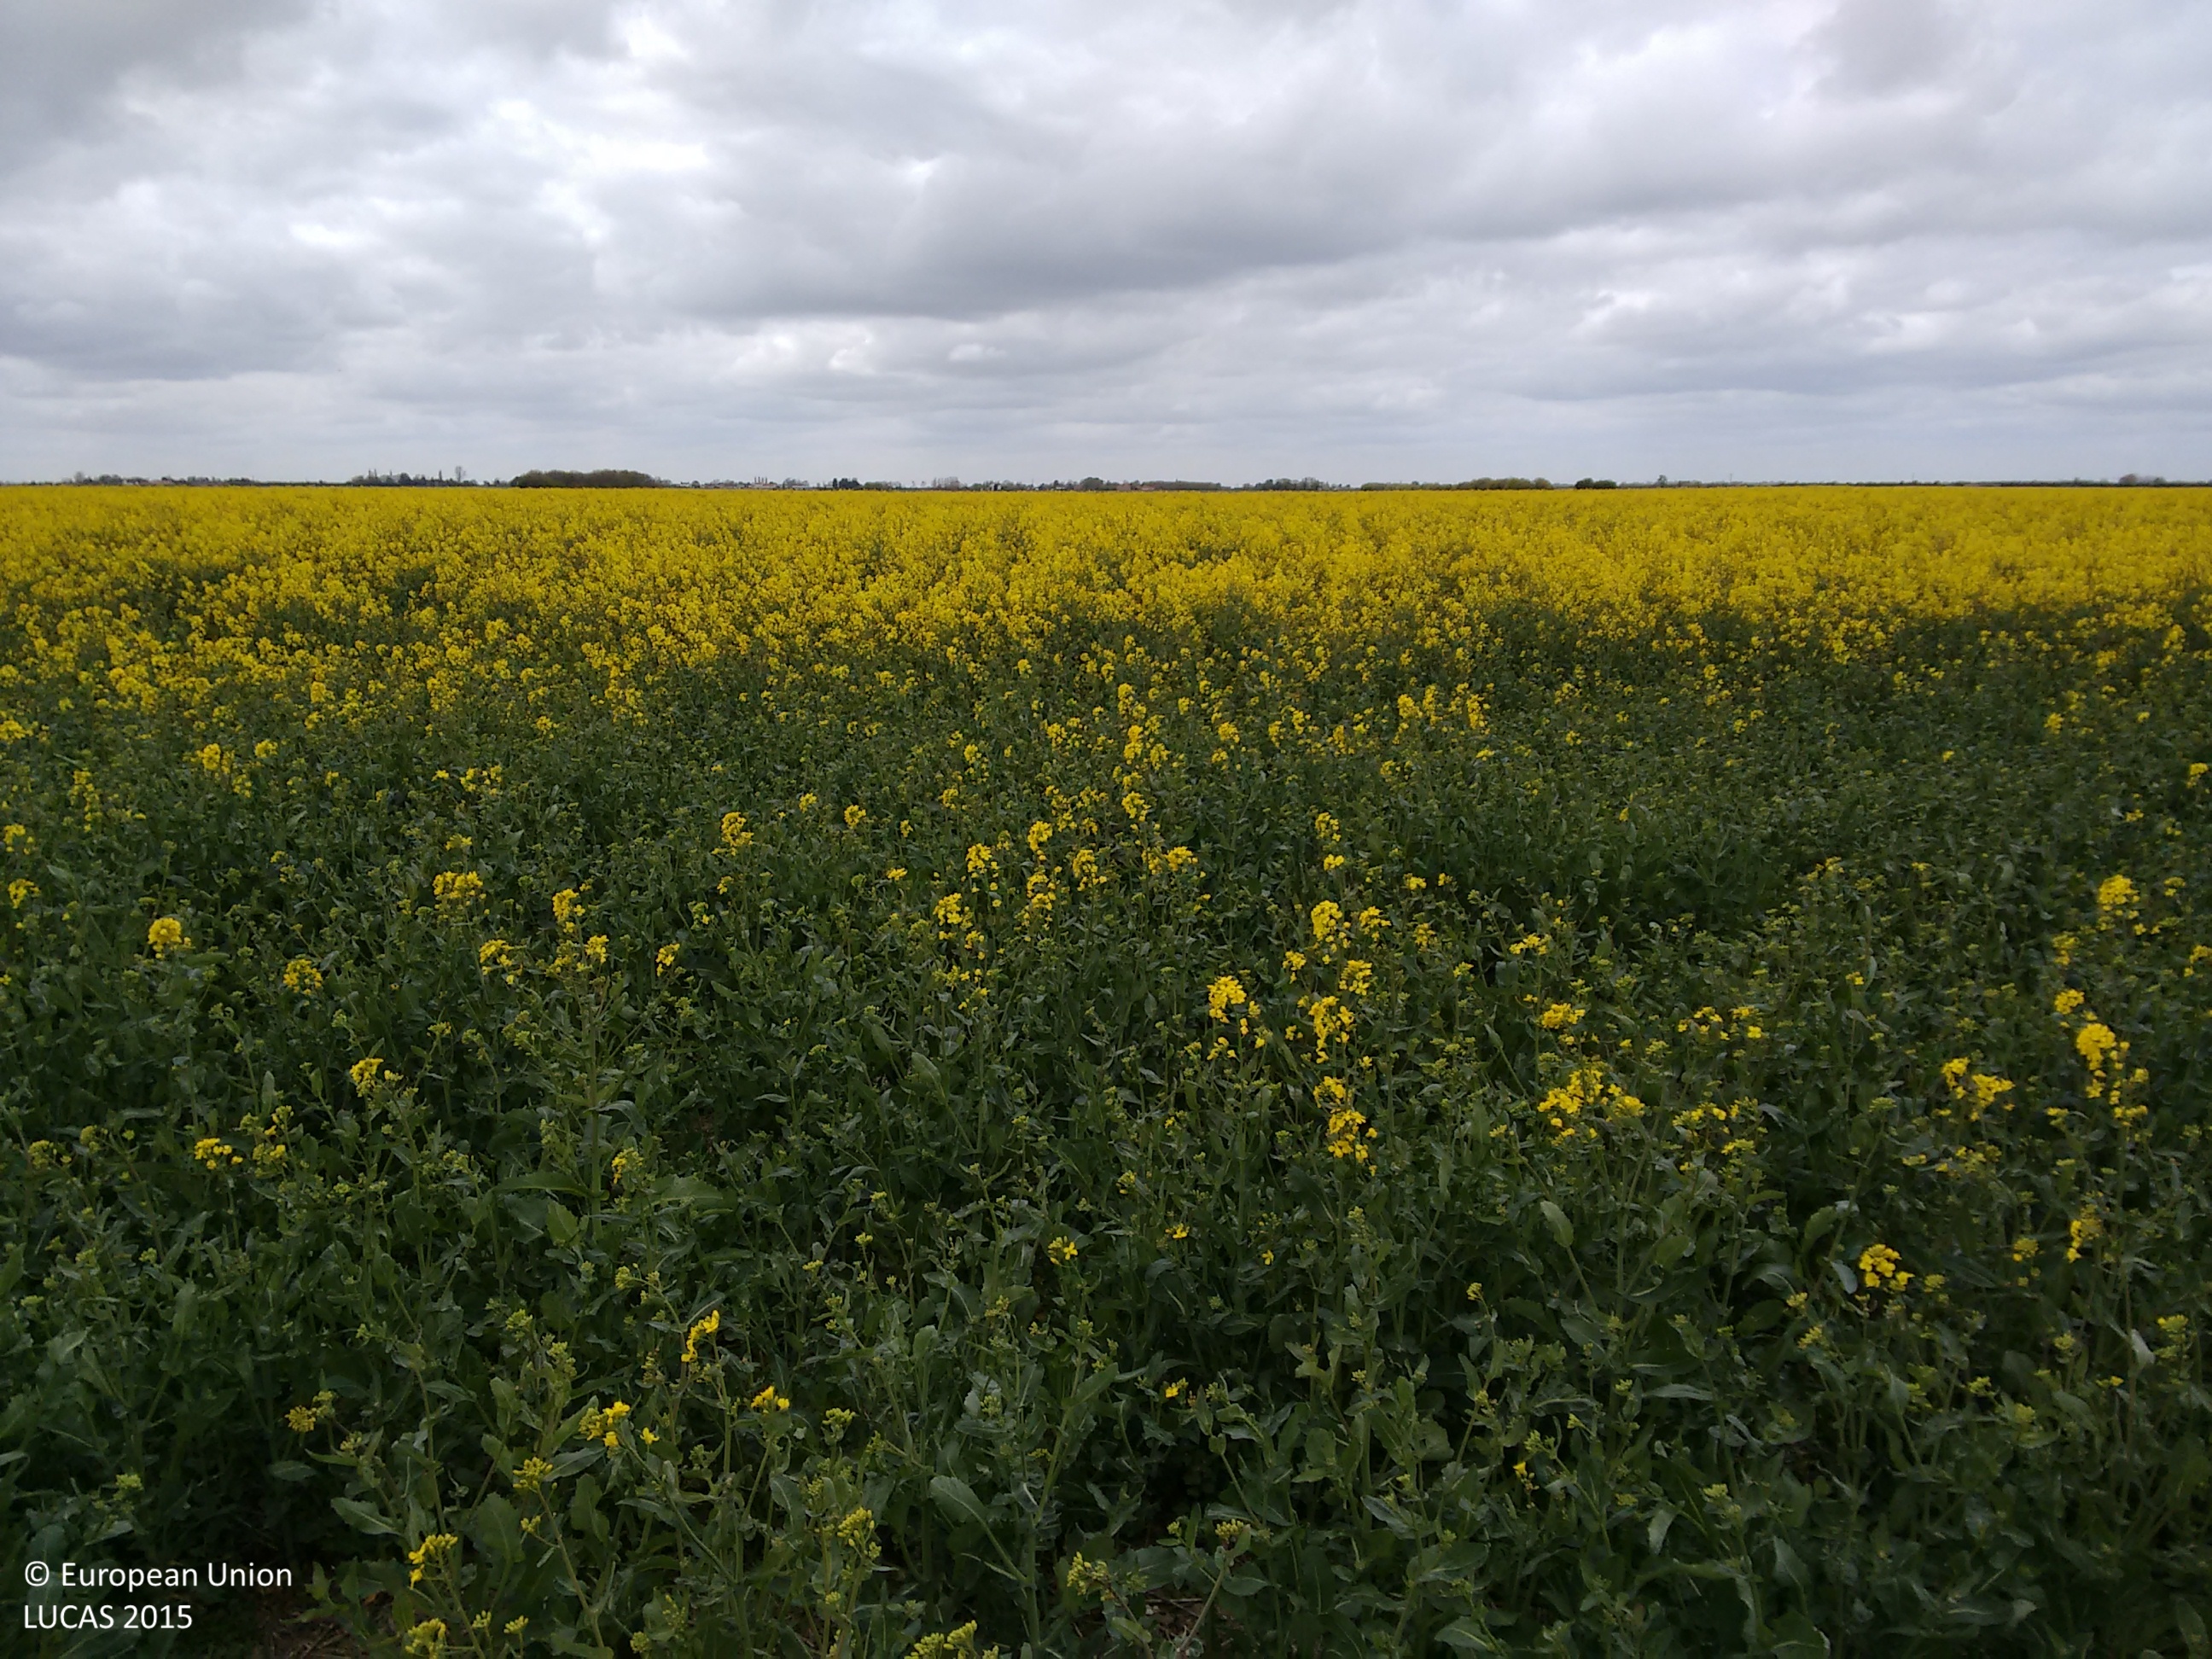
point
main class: Cropland
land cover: Rape and turnip rape
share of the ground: > 75 %
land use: Agriculture (excluding fallow land and kitchen gardens)
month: May
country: GB
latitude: 53.0632
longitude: 0.0449
